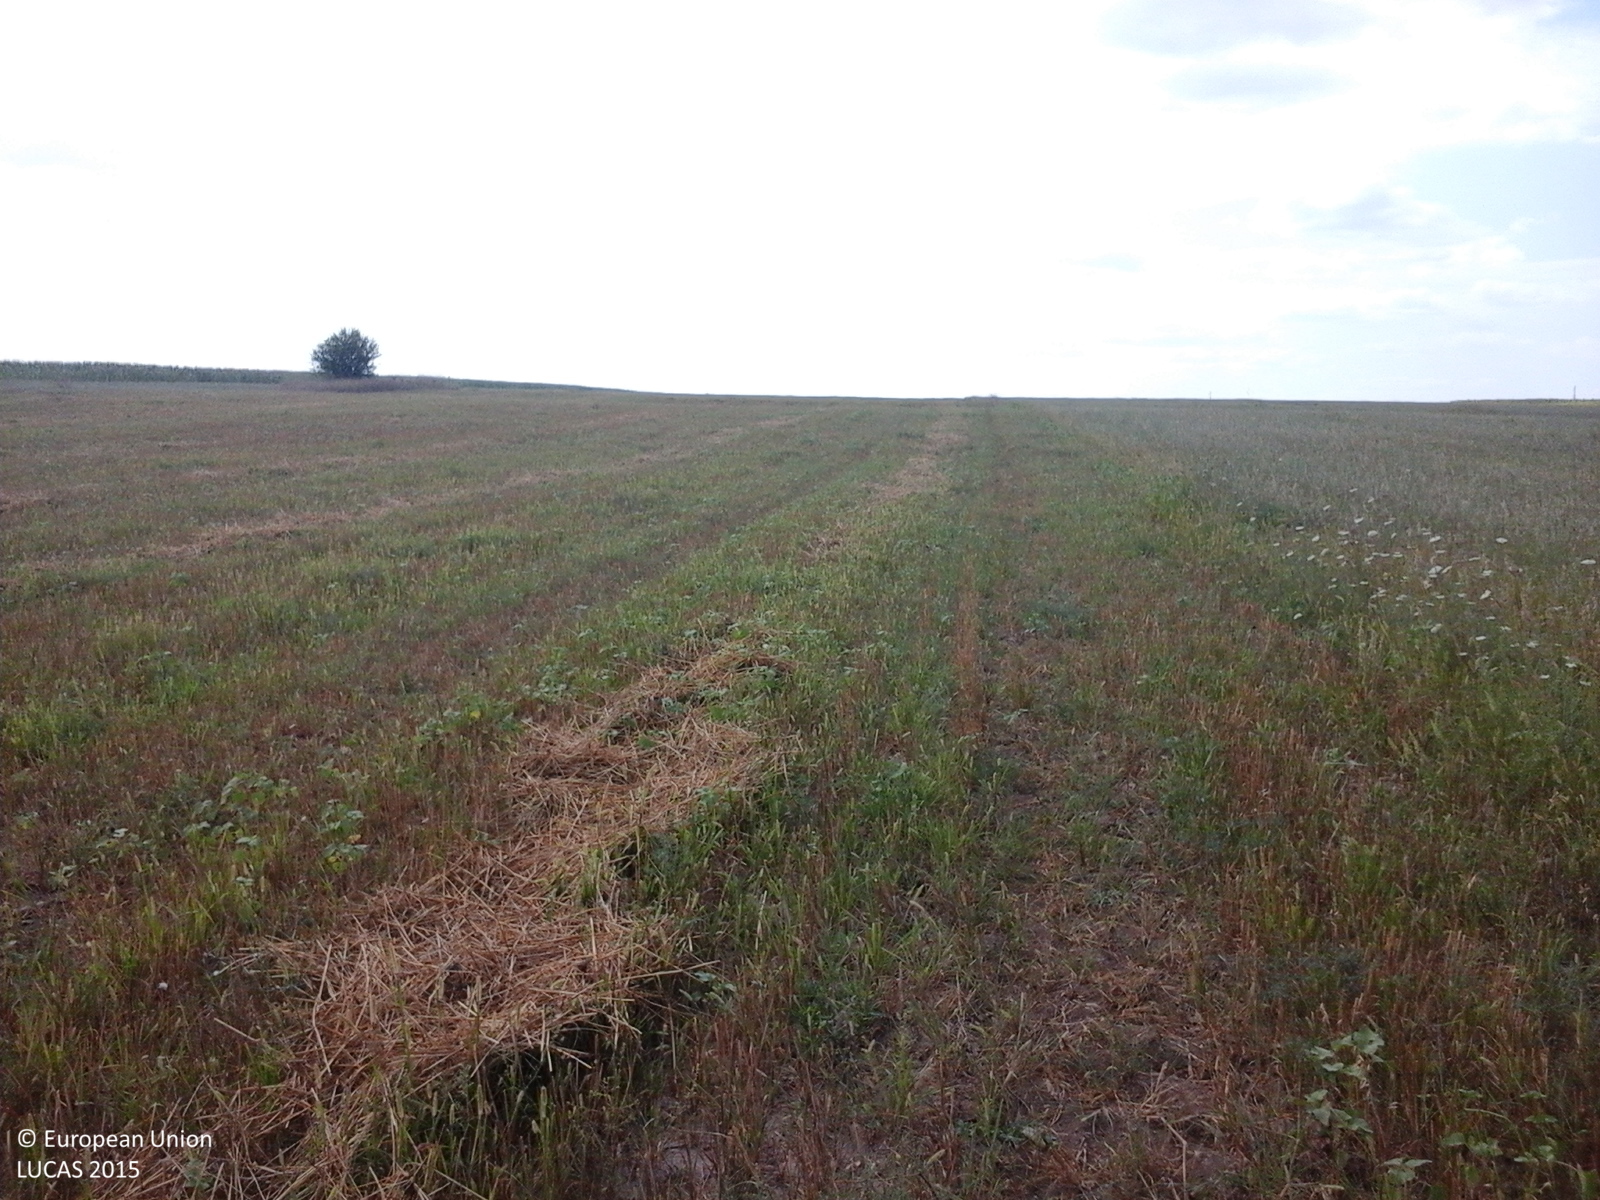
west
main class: Cropland
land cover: Oats
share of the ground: 10 - 25 %
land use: Agriculture (excluding fallow land and kitchen gardens)
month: August
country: RO
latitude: 44.7422
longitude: 28.1626
